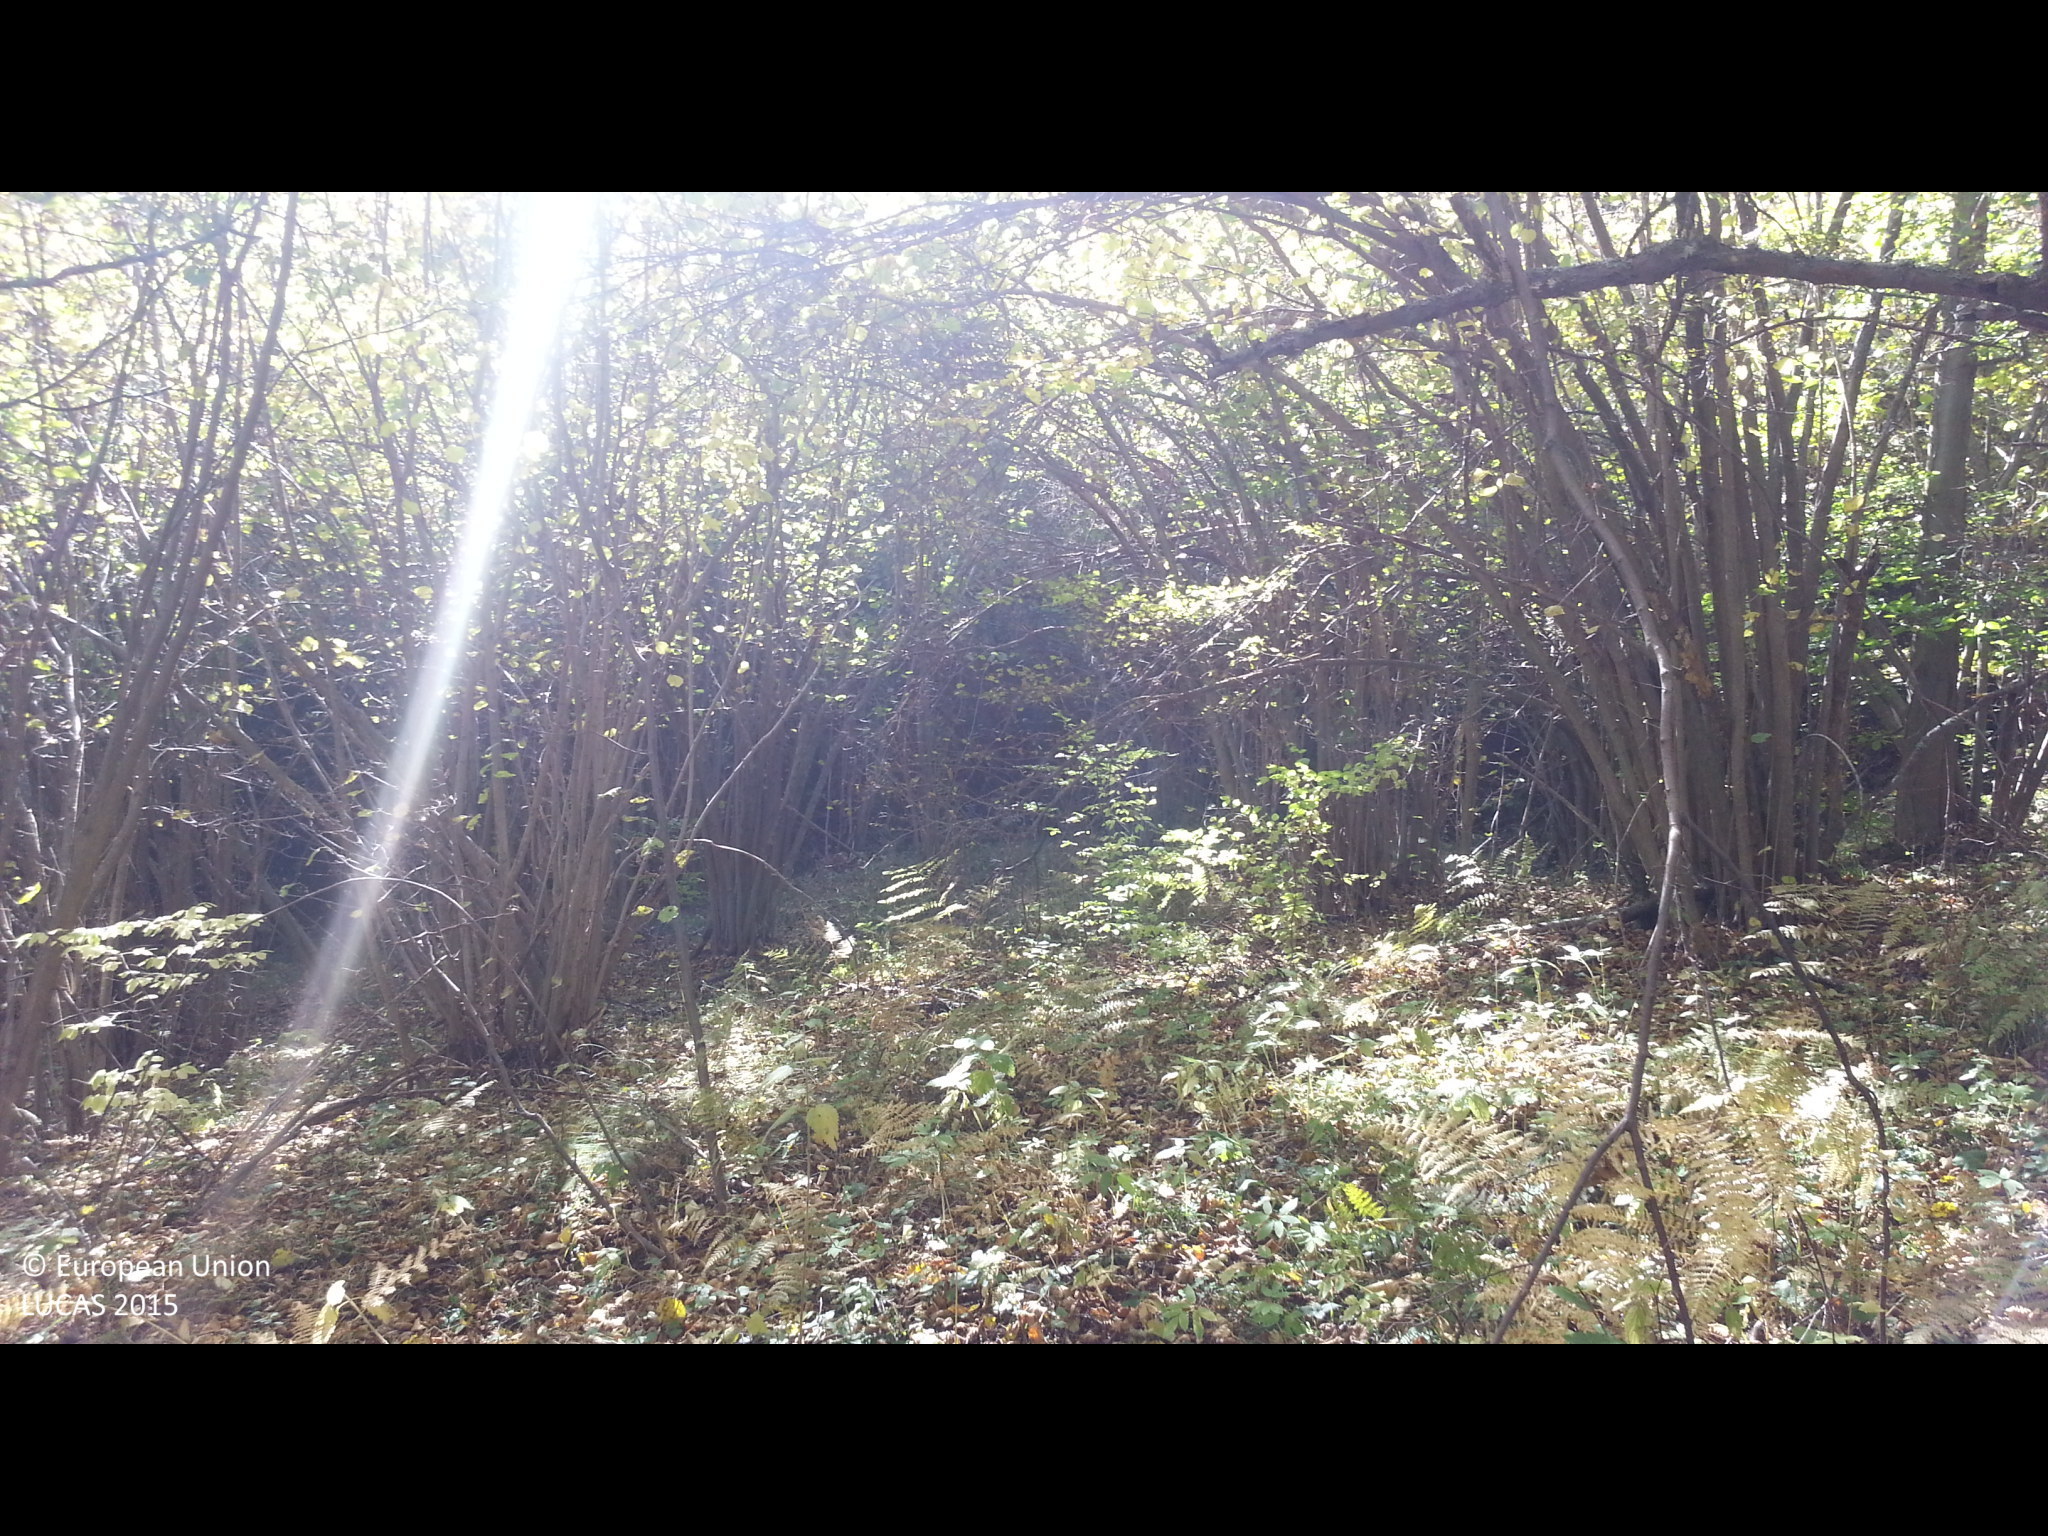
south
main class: Woodland
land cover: Broadleaved woodland
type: mesophytic deciduous forest
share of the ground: 50 - 75 %
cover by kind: broadleaved forest trees 65 %, herbaceous plants 35 %
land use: Forestry
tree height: > 5 m
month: October
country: BG
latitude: 42.4720
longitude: 23.4004
